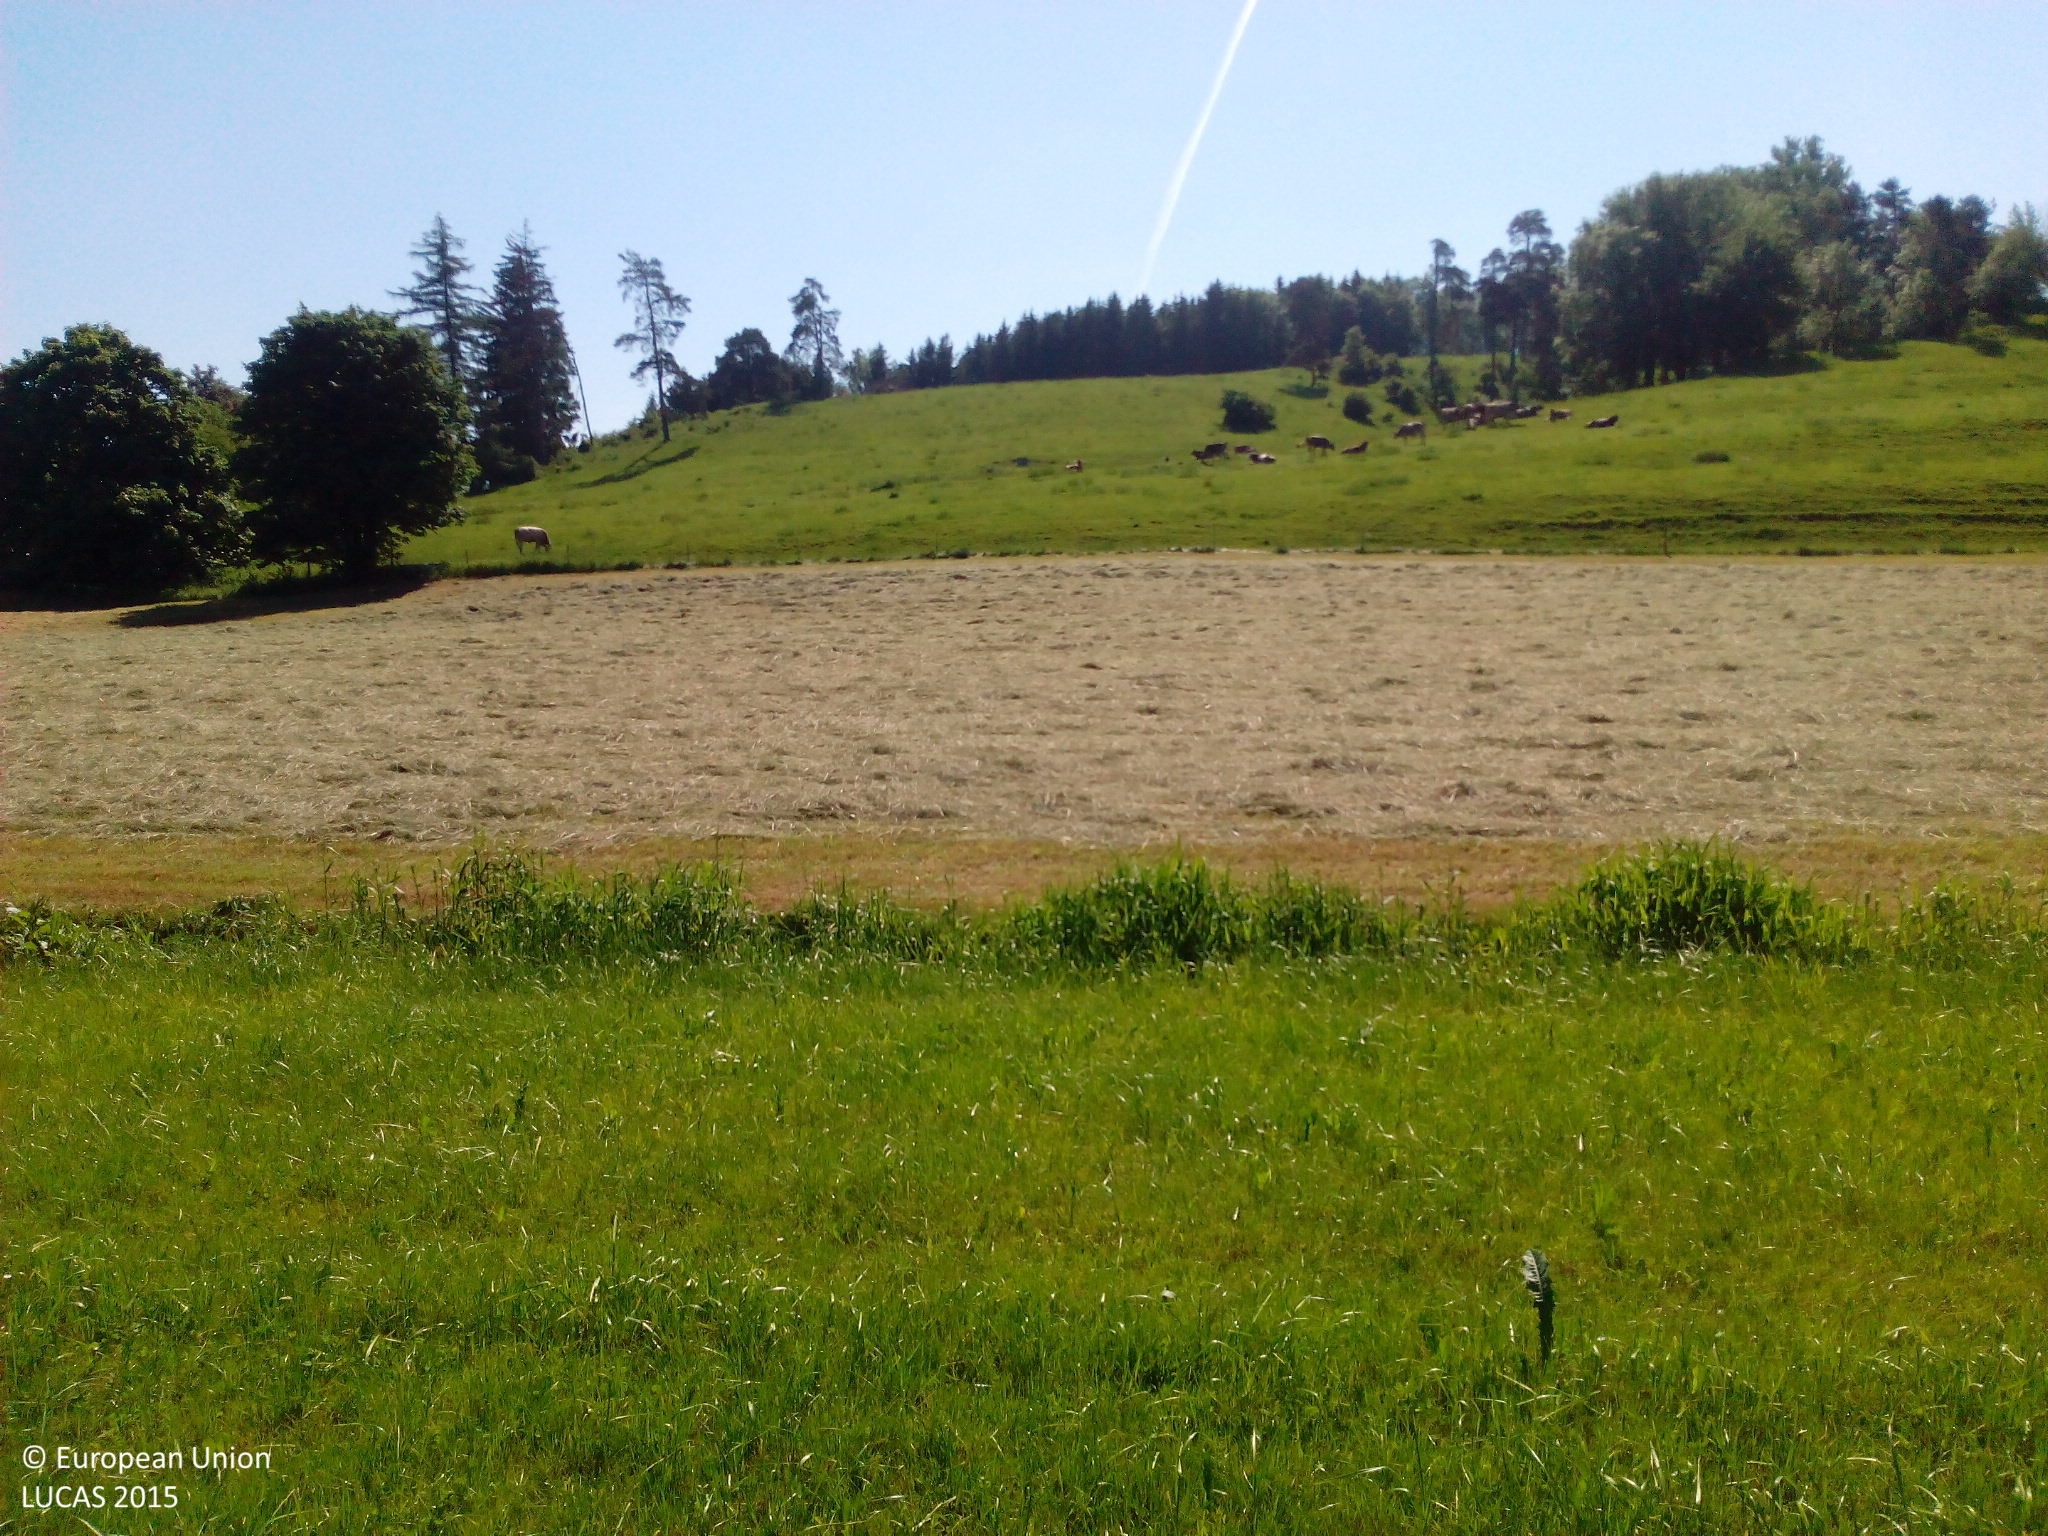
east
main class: Grassland
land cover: Grassland without tree/shrub cover
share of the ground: > 75 %
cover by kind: herbaceous plants 100 %
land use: Agriculture (excluding fallow land and kitchen gardens)
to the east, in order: Grassland without tree/shrub cover; Ditches and canals; Grassland without tree/shrub cover; Fences; Grassland without tree/shrub cover; Fences; Broadleaved woodland; Spruce dominated coniferous woodland; Grassland without tree/shrub cover
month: June
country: DE
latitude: 47.7724
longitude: 10.5200
